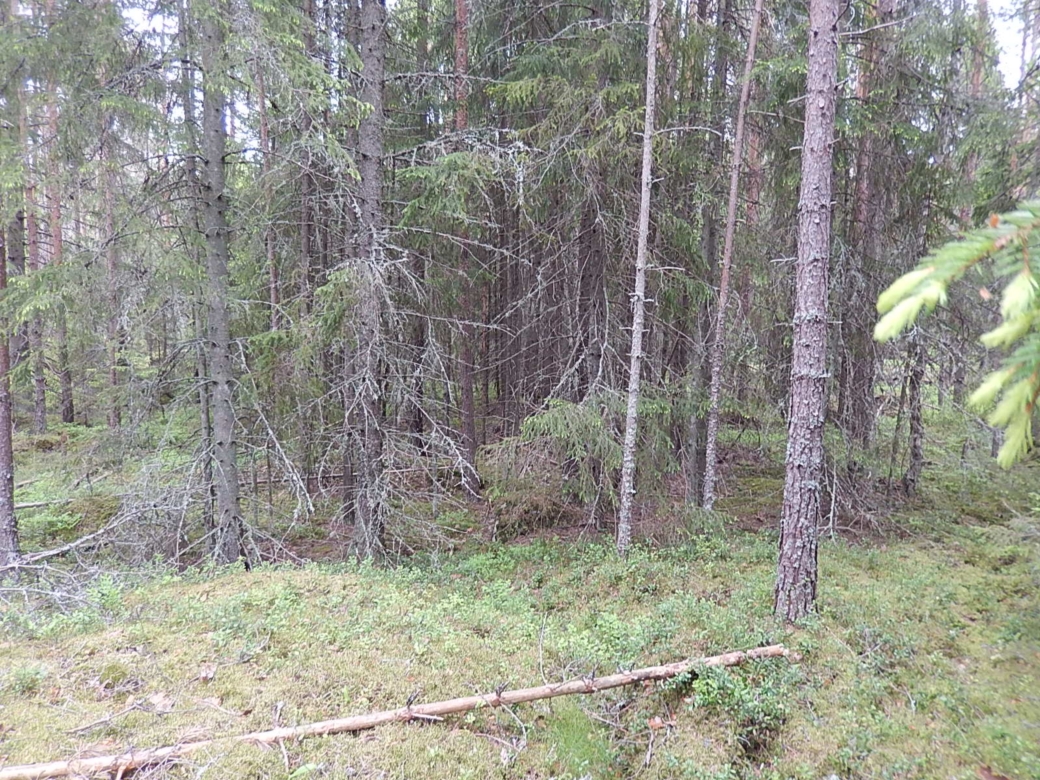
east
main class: Woodland
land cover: Other coniferous woodland
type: boreal forest
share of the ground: > 75 %
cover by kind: coniferous forest trees 80 %, lichens and mosses 10 %, broadleaved forest trees 5 %, shrubs 5 %
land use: Forestry
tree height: > 5 m
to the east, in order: Other coniferous woodland; Spruce dominated mixed woodland; Ditches and canals; Spruce dominated mixed woodland; Other coniferous woodland; Pine dominated coniferous woodland; Other coniferous woodland
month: June
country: FI
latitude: 61.8003
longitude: 21.5638
